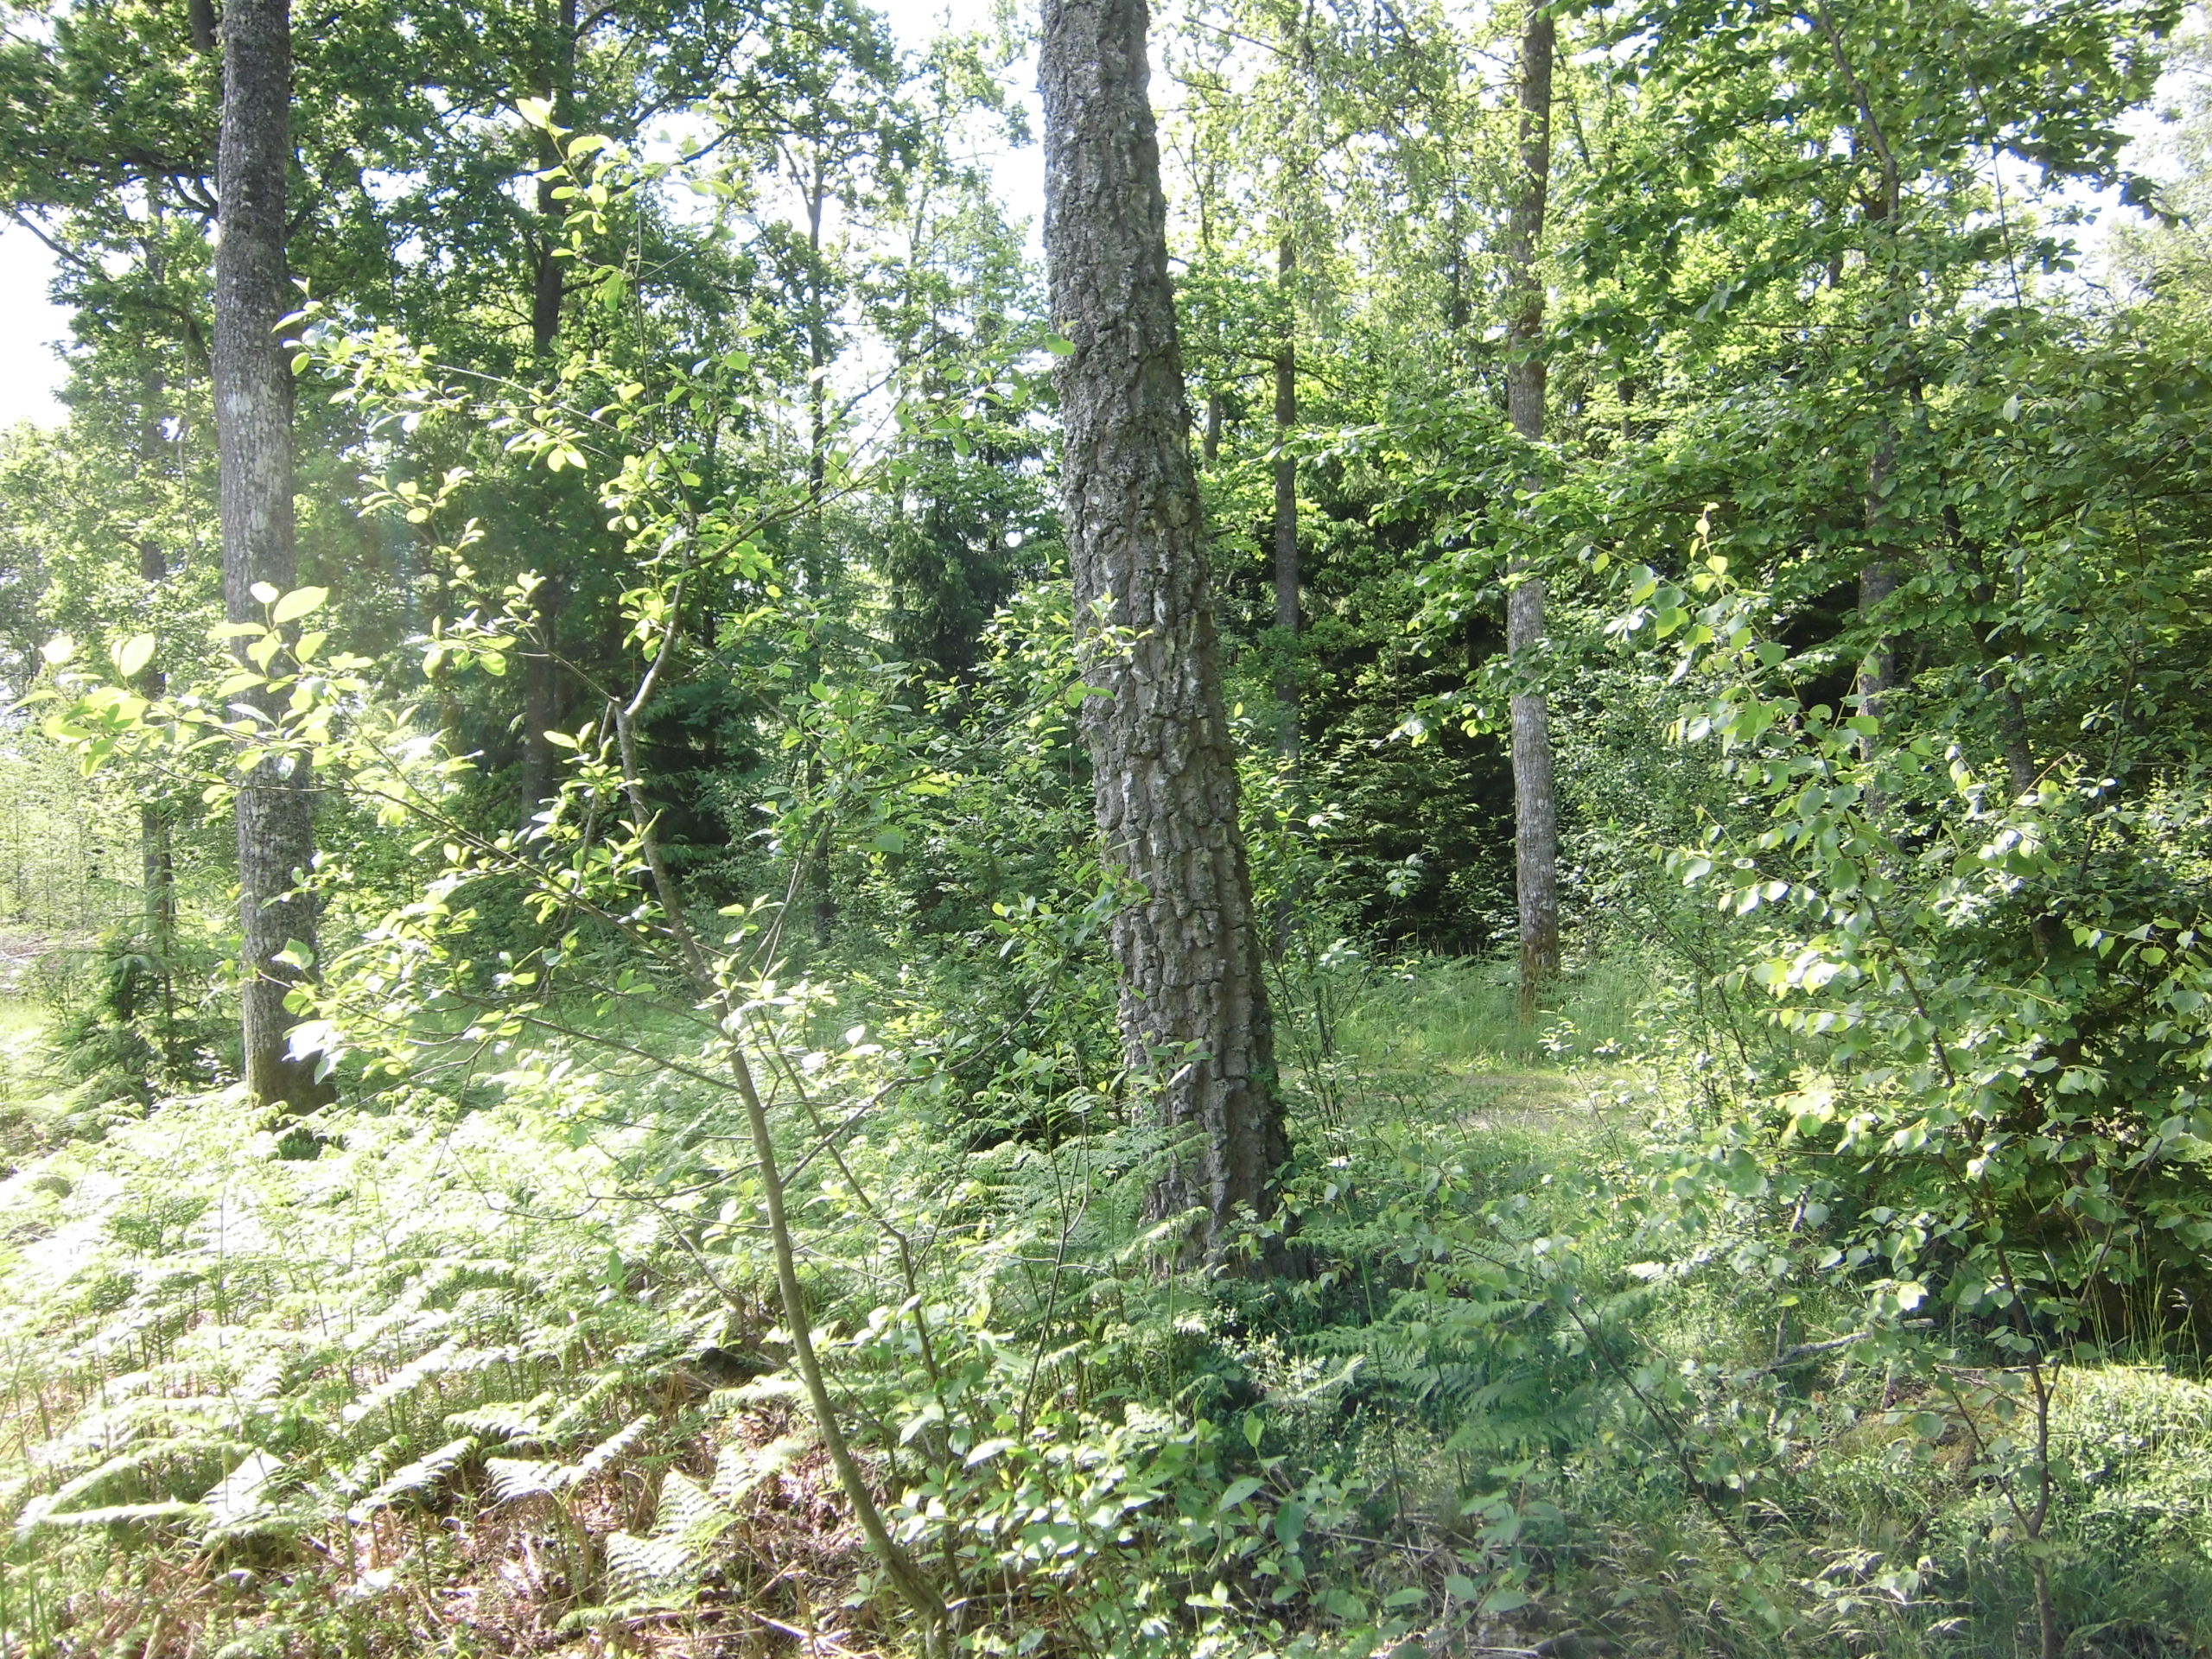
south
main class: Woodland
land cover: Broadleaved woodland
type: boreal forest
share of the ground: 50 - 75 %
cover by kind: broadleaved forest trees 55 %, herbaceous plants 20 %, coniferous forest trees 10 %, shrubs 10 %, lichens and mosses 5 %
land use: Forestry
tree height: > 5 m
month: June
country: SE
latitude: 56.9824
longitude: 14.7523
